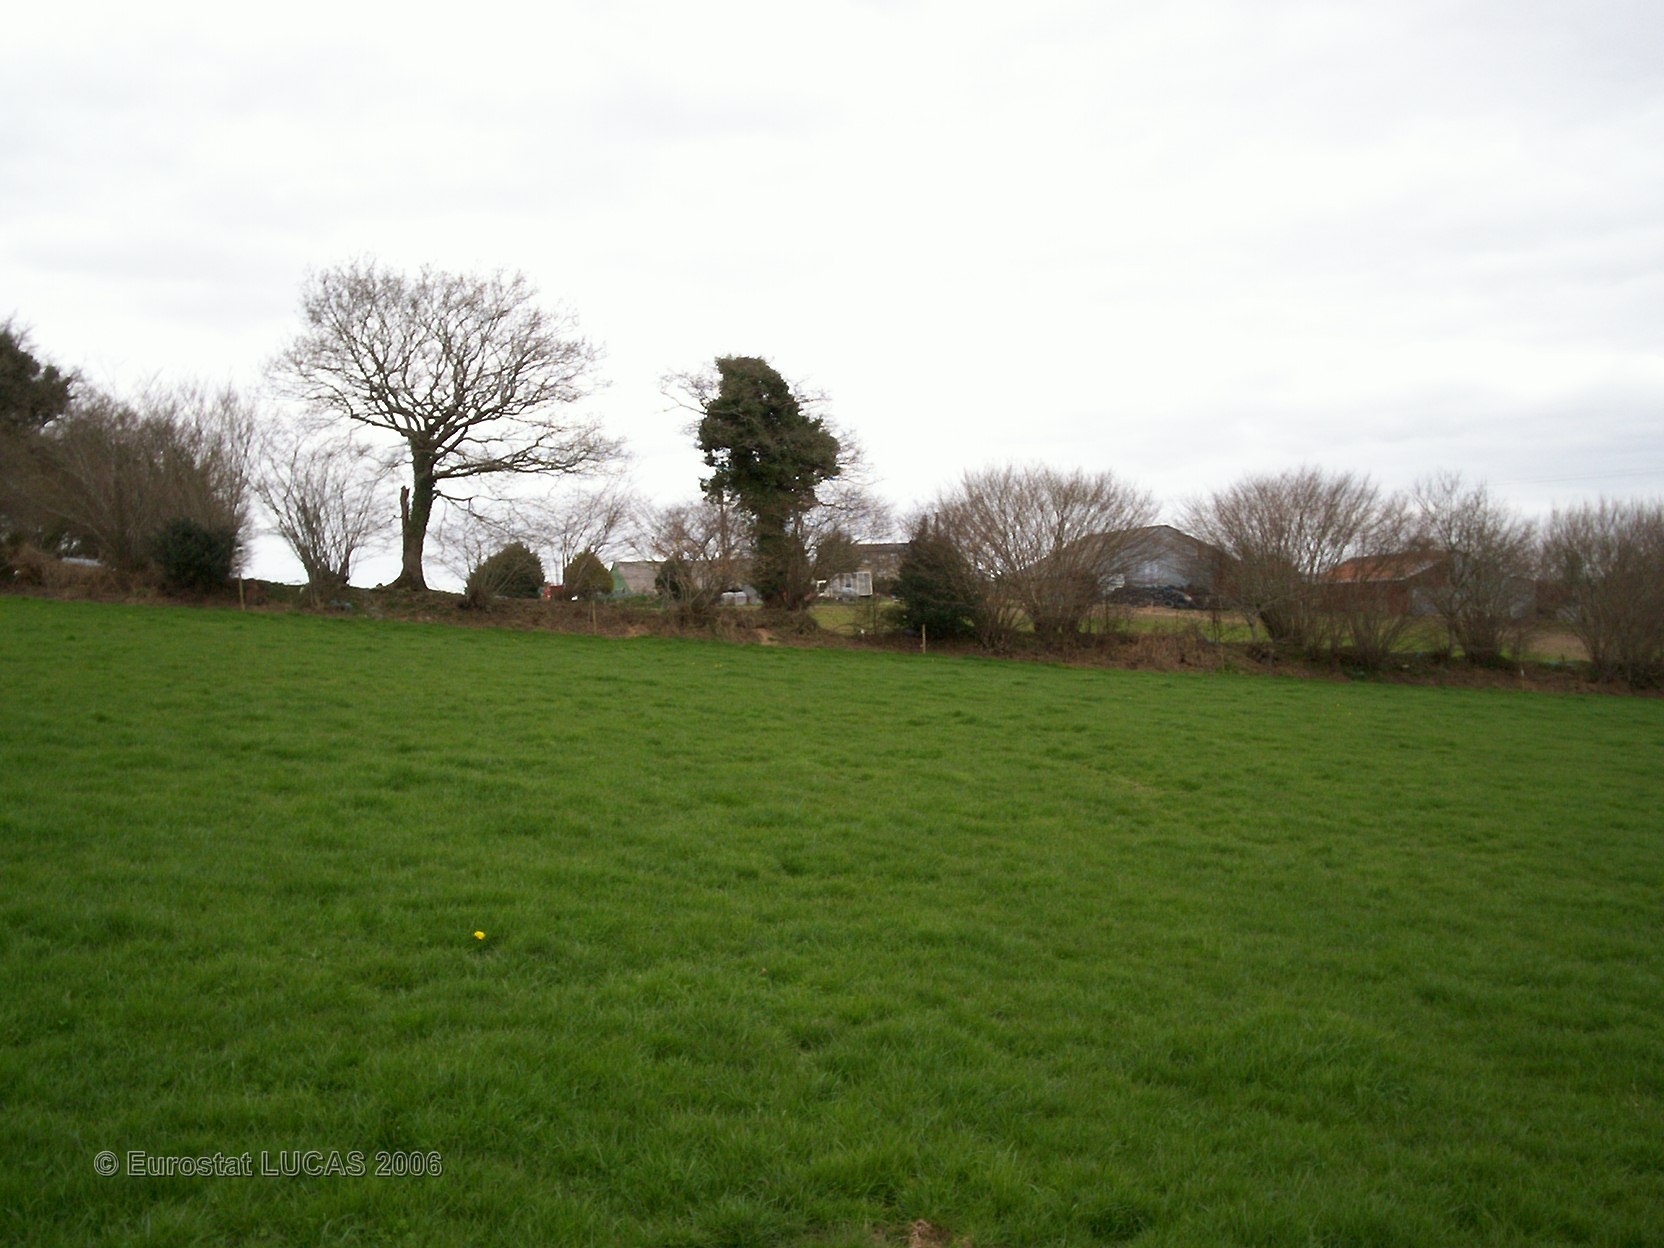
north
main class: Grassland
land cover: Grassland without tree/shrub cover
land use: Agriculture (excluding fallow land and kitchen gardens)
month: April
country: FR
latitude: 48.1935
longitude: -3.6270
